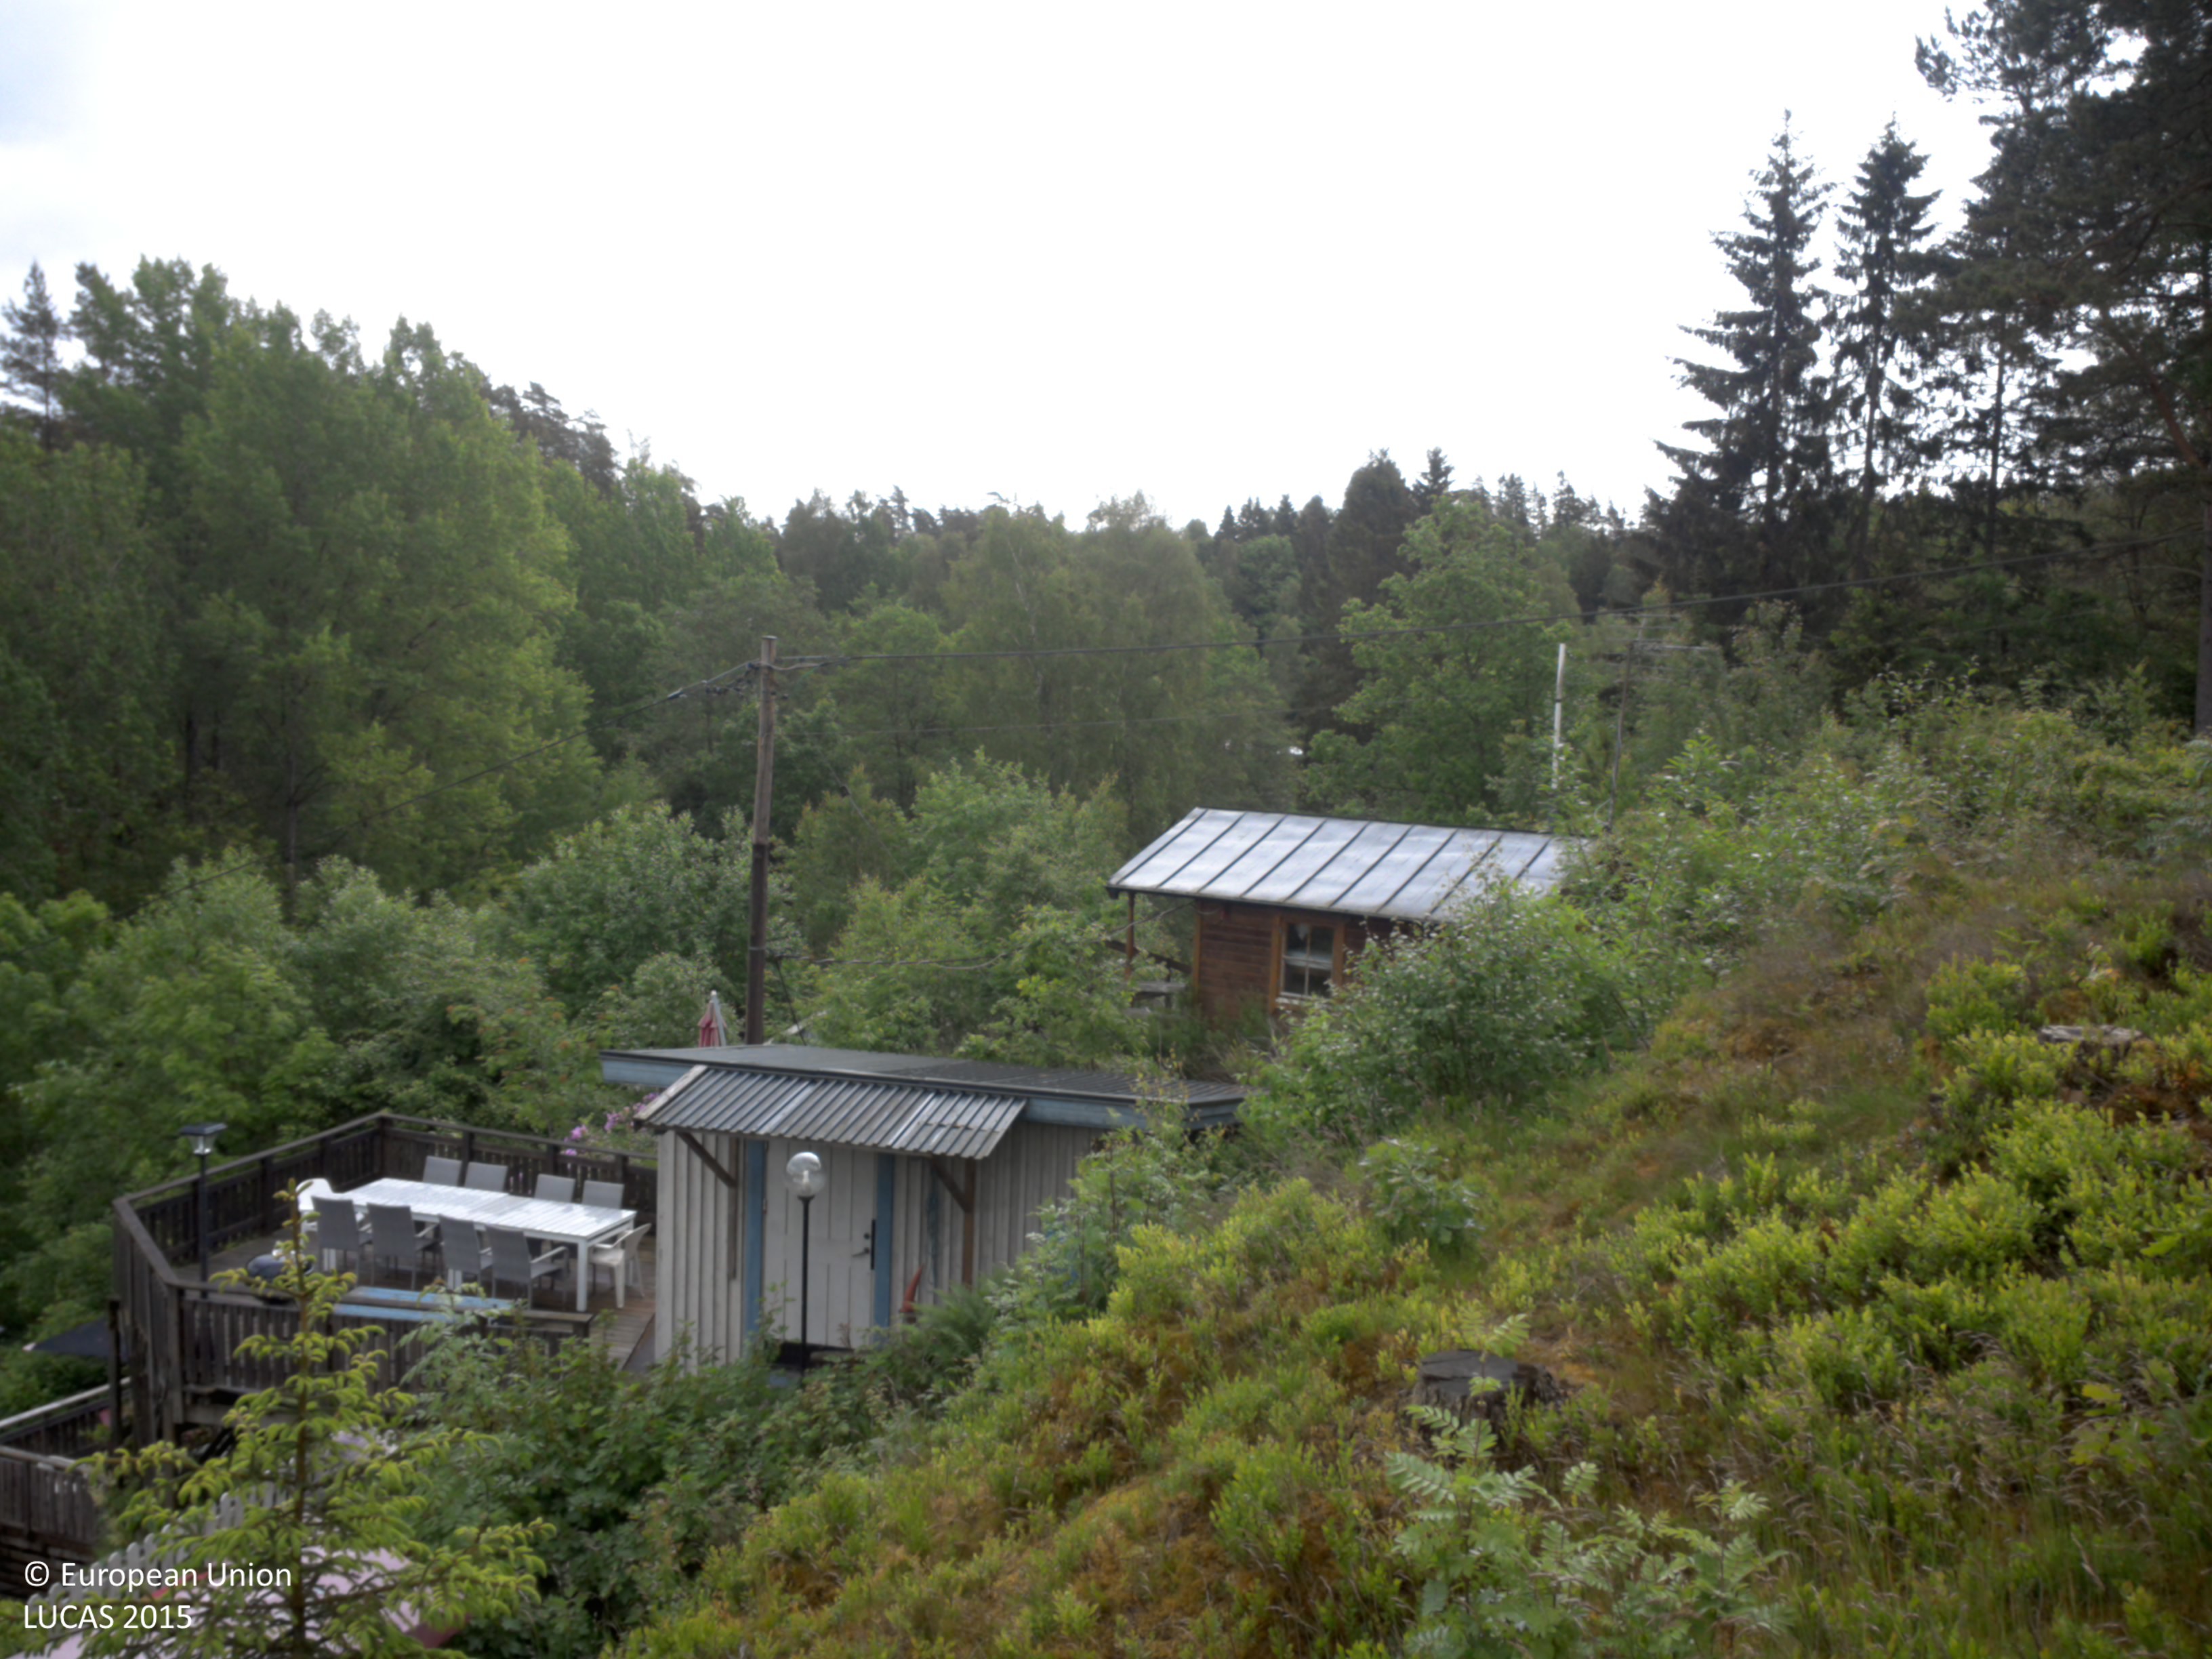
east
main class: Woodland
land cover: Pine dominated coniferous woodland
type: boreal forest
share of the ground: < 10 %
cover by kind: shrubs 80 %, coniferous forest trees 10 %, herbaceous plants 5 %, lichens and mosses 5 %
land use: Amenities, museums, leisure
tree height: > 5 m
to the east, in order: Pine dominated coniferous woodland; Artificial constructions in urban areas; Broadleaved woodland; Electric lines; Rivers and streams; Broadleaved woodland; Artificial constructions in urban areas; Broadleaved woodland; Ditches and canals; Broadleaved woodland; Paved roads, cycling and walking lanes; Pine dominated mixed woodland; Rock outcrops; Pine dominated coniferous woodland; Spruce dominated mixed woodland; Electric lines; Spruce dominated mixed woodland
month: June
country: SE
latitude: 58.4247
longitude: 11.6916
